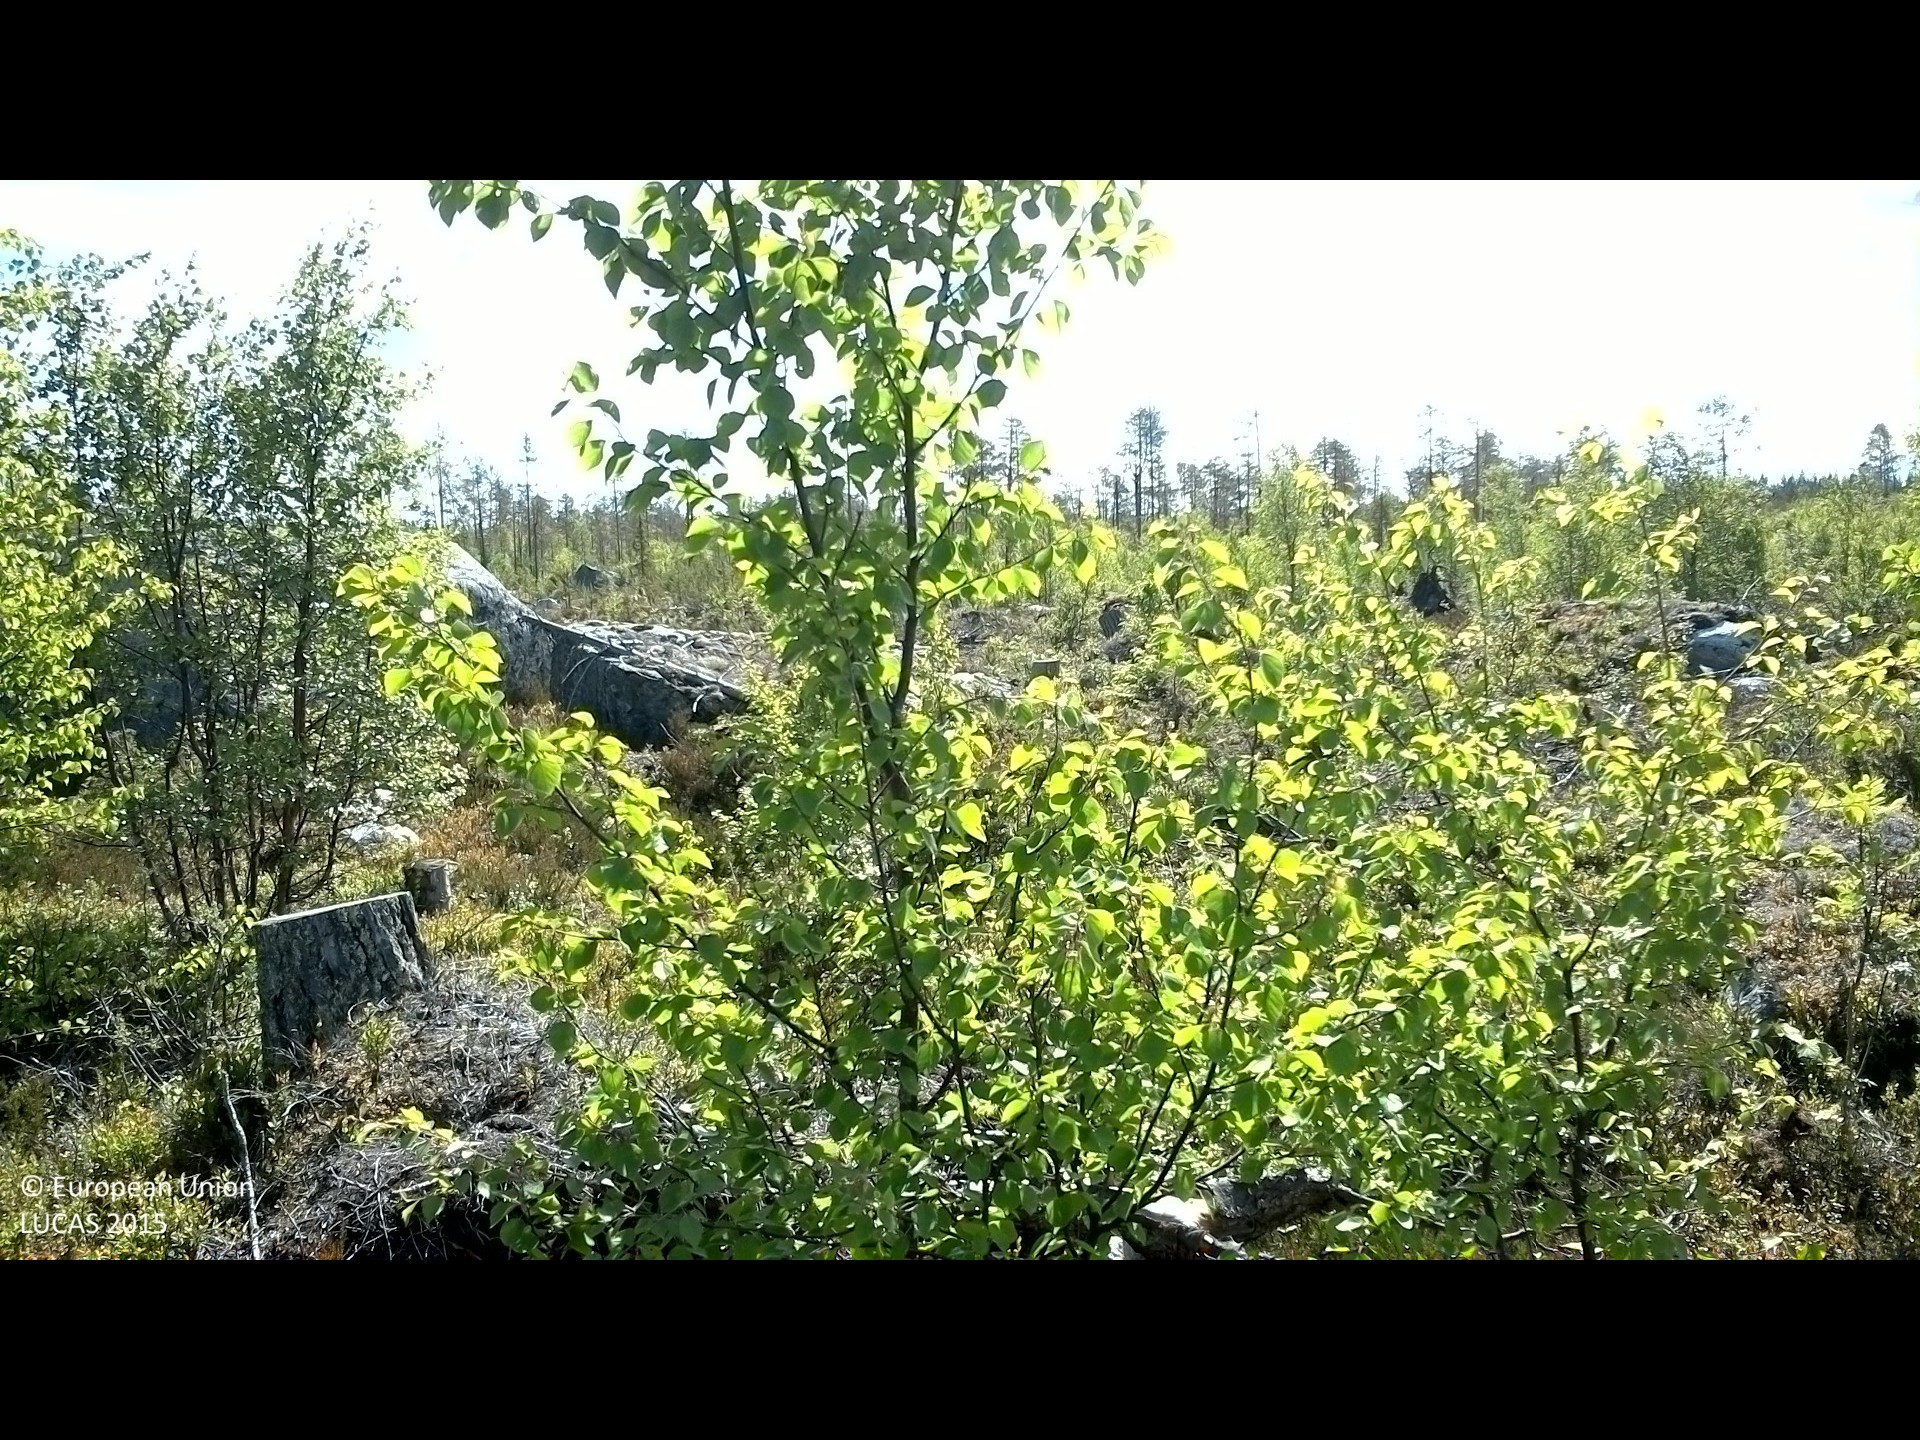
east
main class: Woodland
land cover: Broadleaved woodland
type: boreal forest
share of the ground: 10 - 25 %
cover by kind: shrubs 60 %, broadleaved forest trees 20 %, lichens and mosses 15 %, coniferous forest trees 5 %
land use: Forestry
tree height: > 5 m
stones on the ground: < 10 %
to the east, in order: Broadleaved woodland; Shrubland with sparse tree cover; Pine dominated coniferous woodland; Pine dominated mixed woodland; Other mixed woodland; Pine dominated mixed woodland
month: June
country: SE
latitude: 62.0488
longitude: 17.4220
